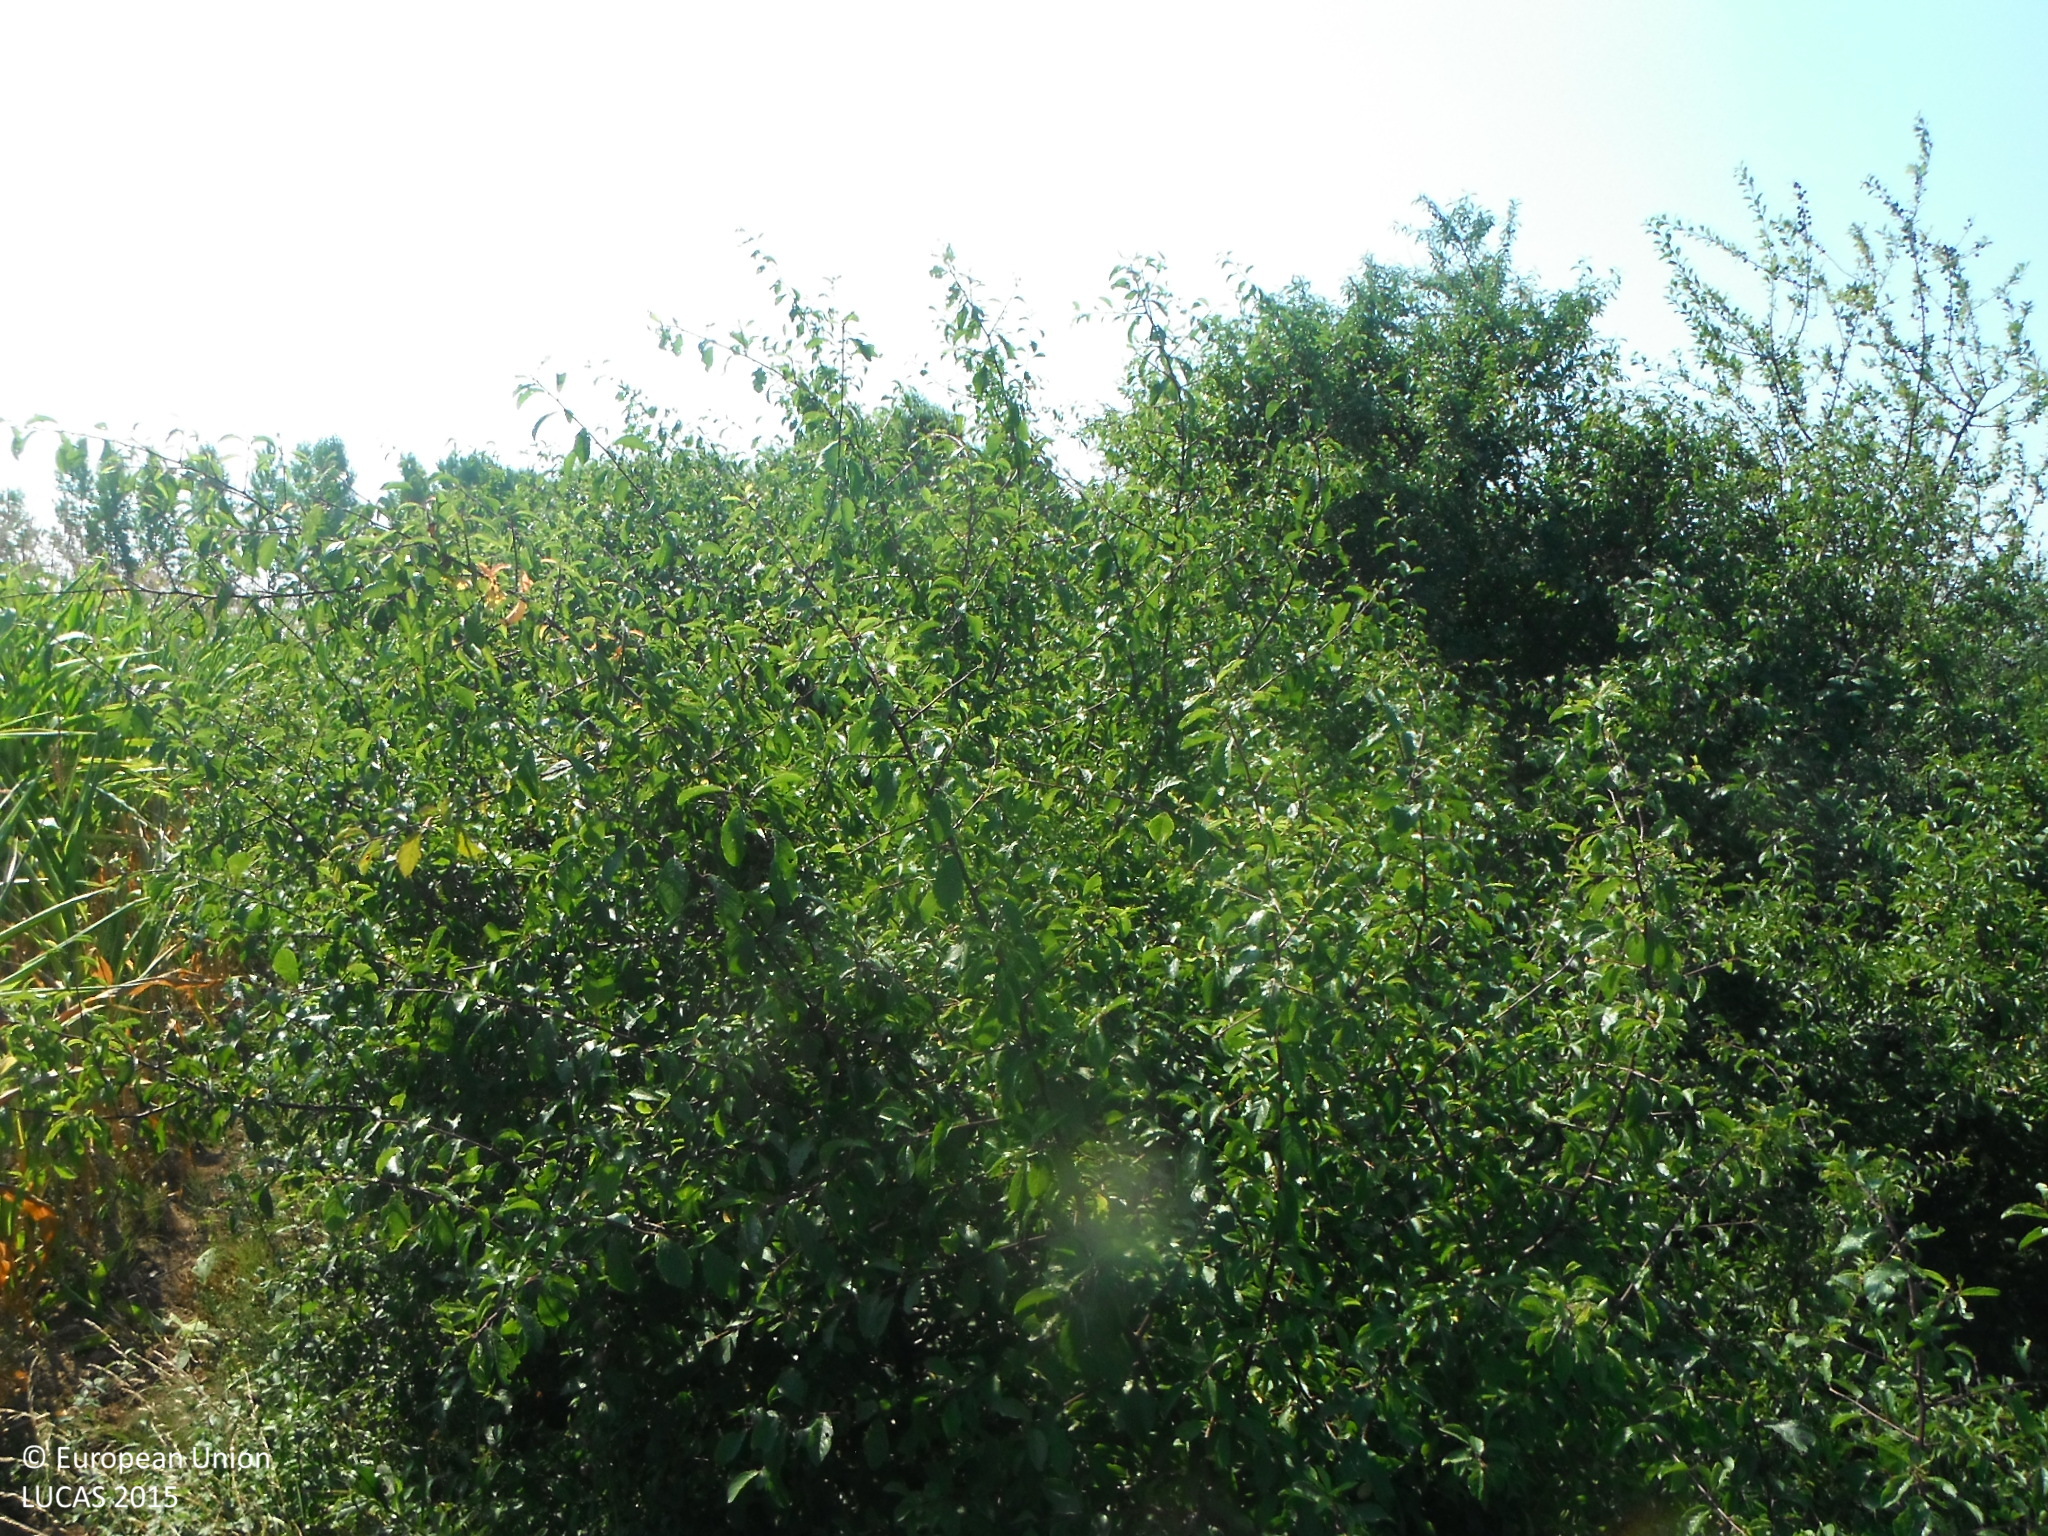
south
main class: Cropland
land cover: Maize
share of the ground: > 75 %
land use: Agriculture (excluding fallow land and kitchen gardens)
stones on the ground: < 10 %
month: August
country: SK
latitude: 48.7318
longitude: 21.9780
